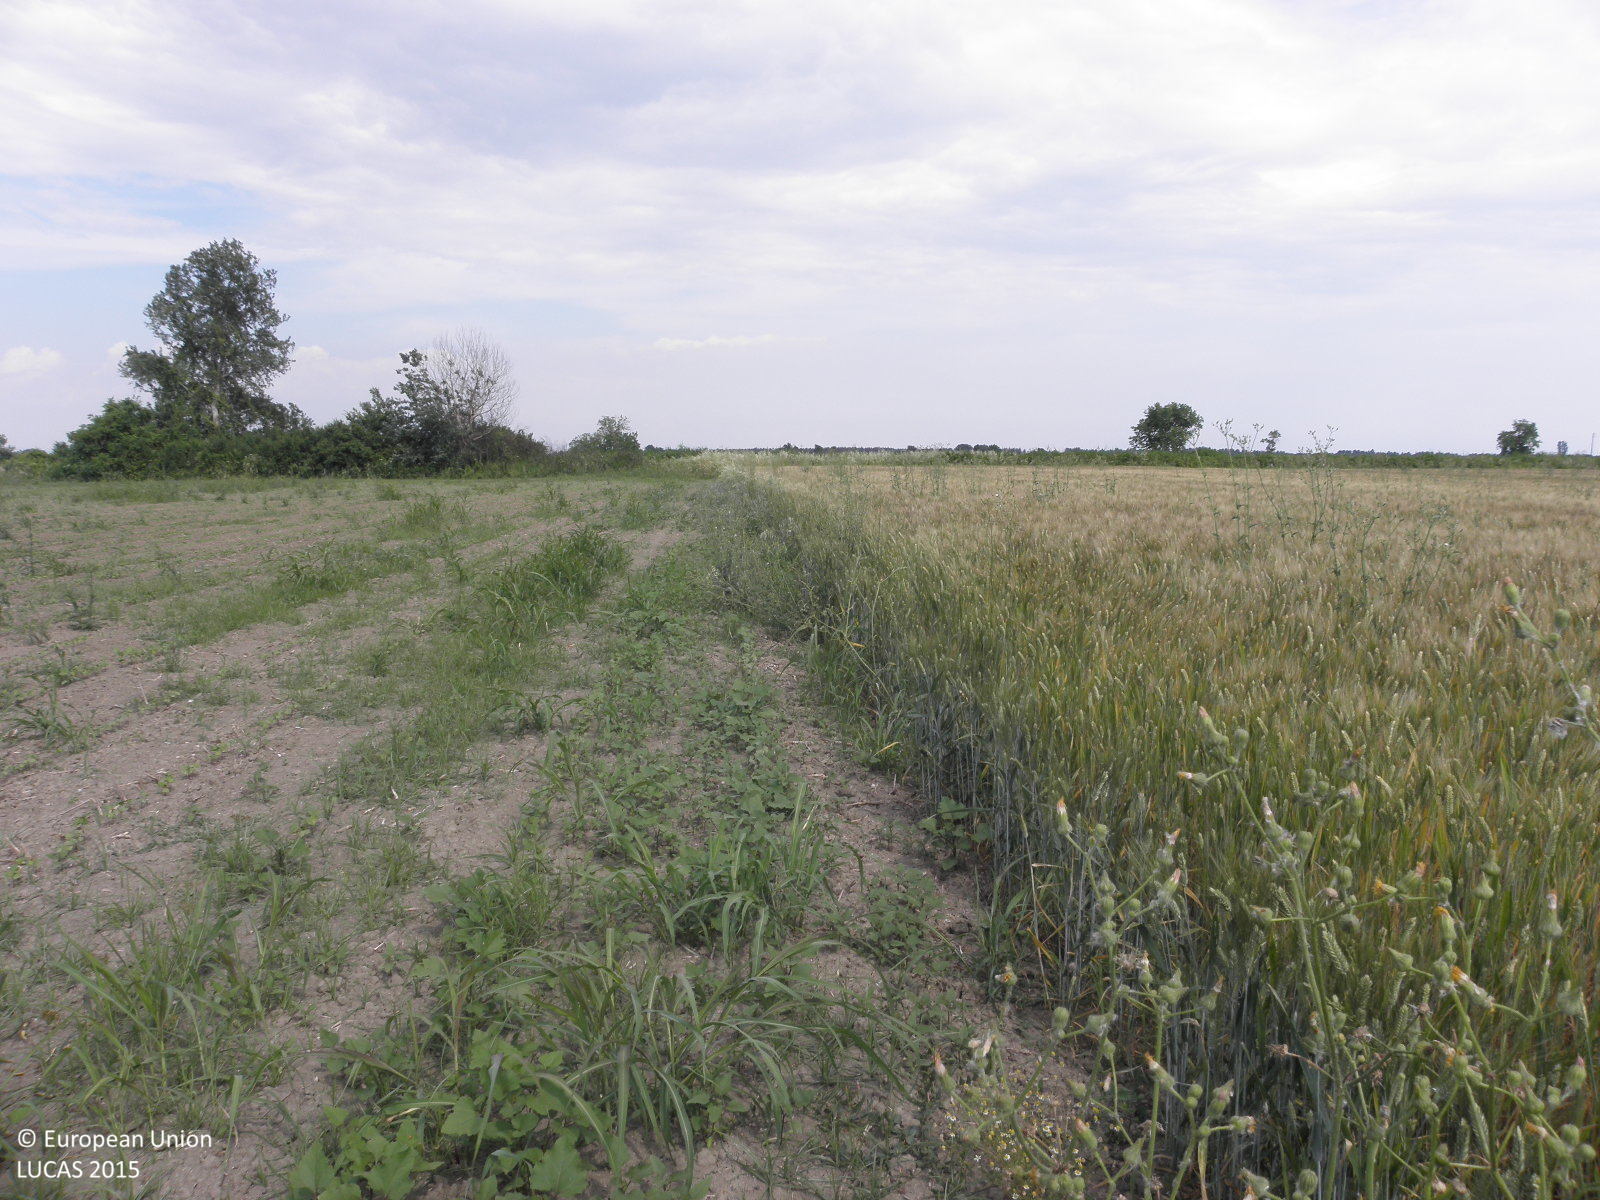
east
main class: Cropland
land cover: Common wheat
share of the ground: > 75 %
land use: Agriculture (excluding fallow land and kitchen gardens)
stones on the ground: < 10 %
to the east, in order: Common wheat; Abandoned hedges; Ditches and canals; Abandoned hedges; Common wheat; Cotton; Grass margins; Paved roads, cycling and walking lanes; Shruby margins; Ditches and canals; Cotton
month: June
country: GR
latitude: 40.5187
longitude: 22.5481
